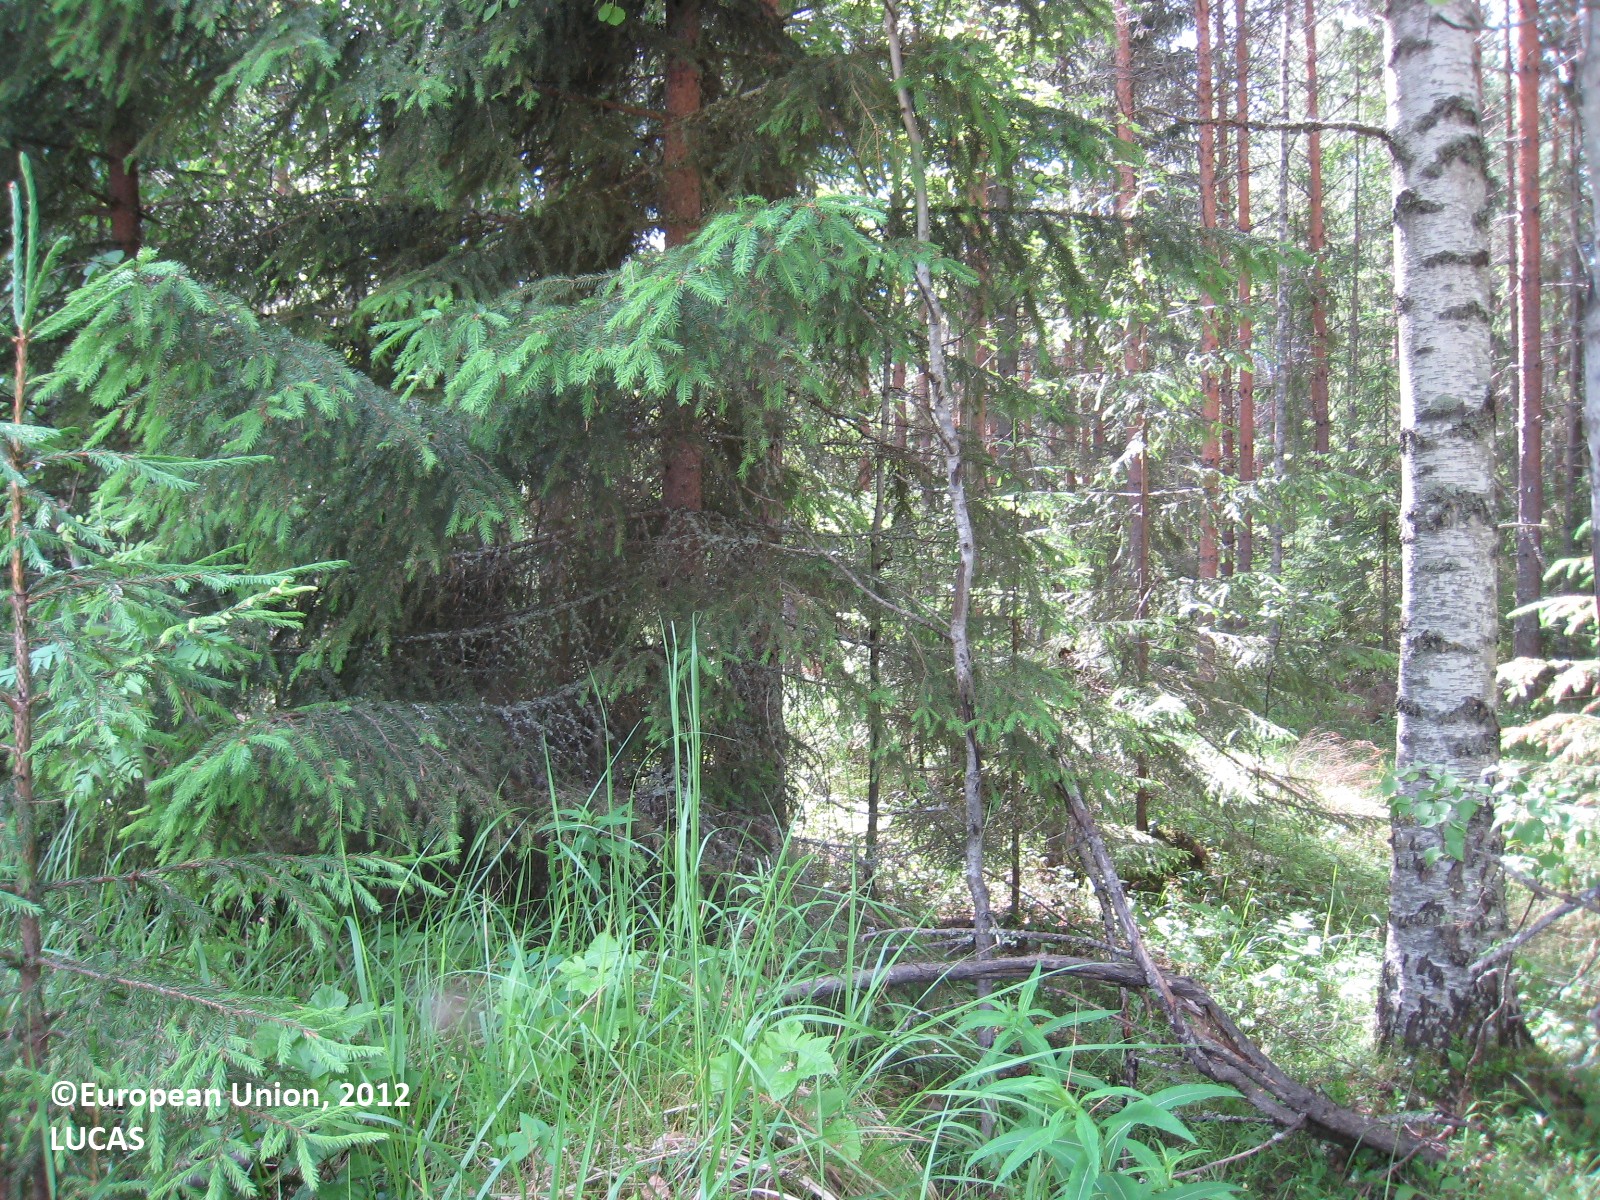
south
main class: Woodland
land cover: Other mixed woodland
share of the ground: 50 - 75 %
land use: Forestry
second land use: Road transport
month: July
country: FI
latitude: 63.2226
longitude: 25.6868
